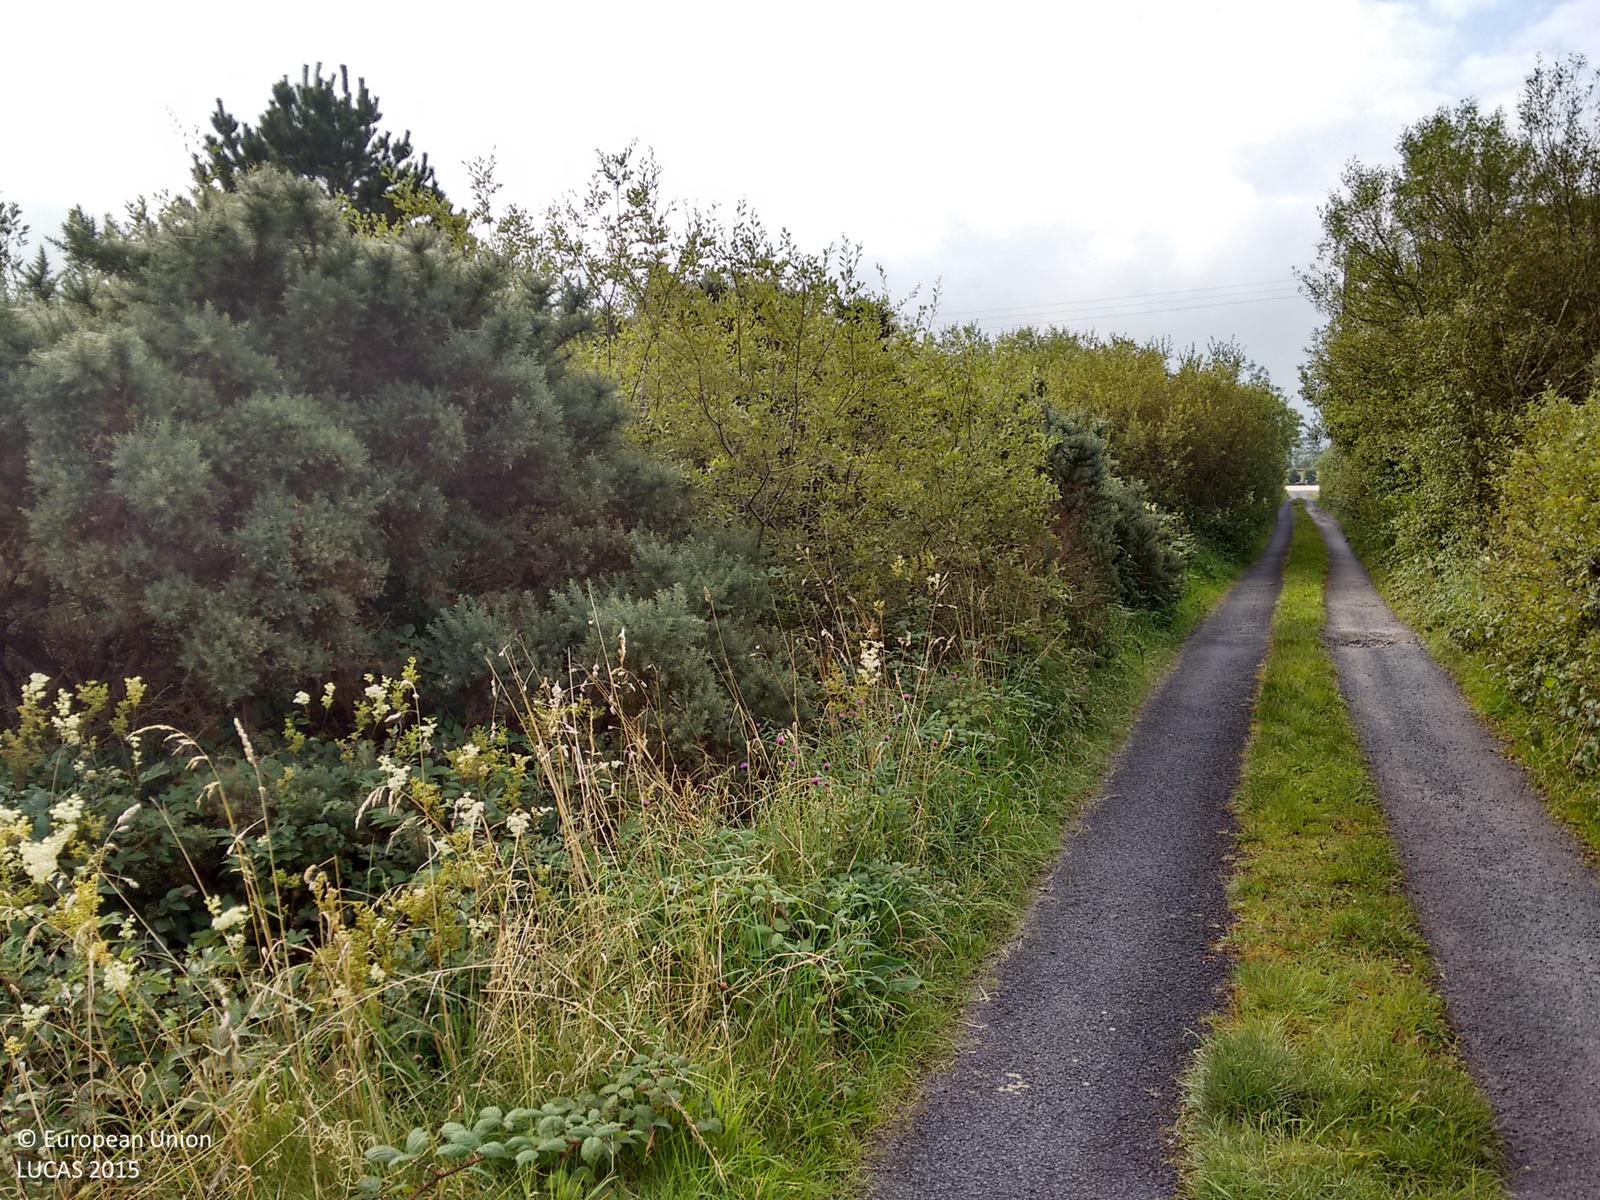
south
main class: Shrubland
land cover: Shrubland without tree cover
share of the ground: > 75 %
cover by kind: shrubs 80 %, herbaceous plants 20 %
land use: Semi-natural and natural areas not in use
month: September
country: IE
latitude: 54.1148
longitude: -9.0128
